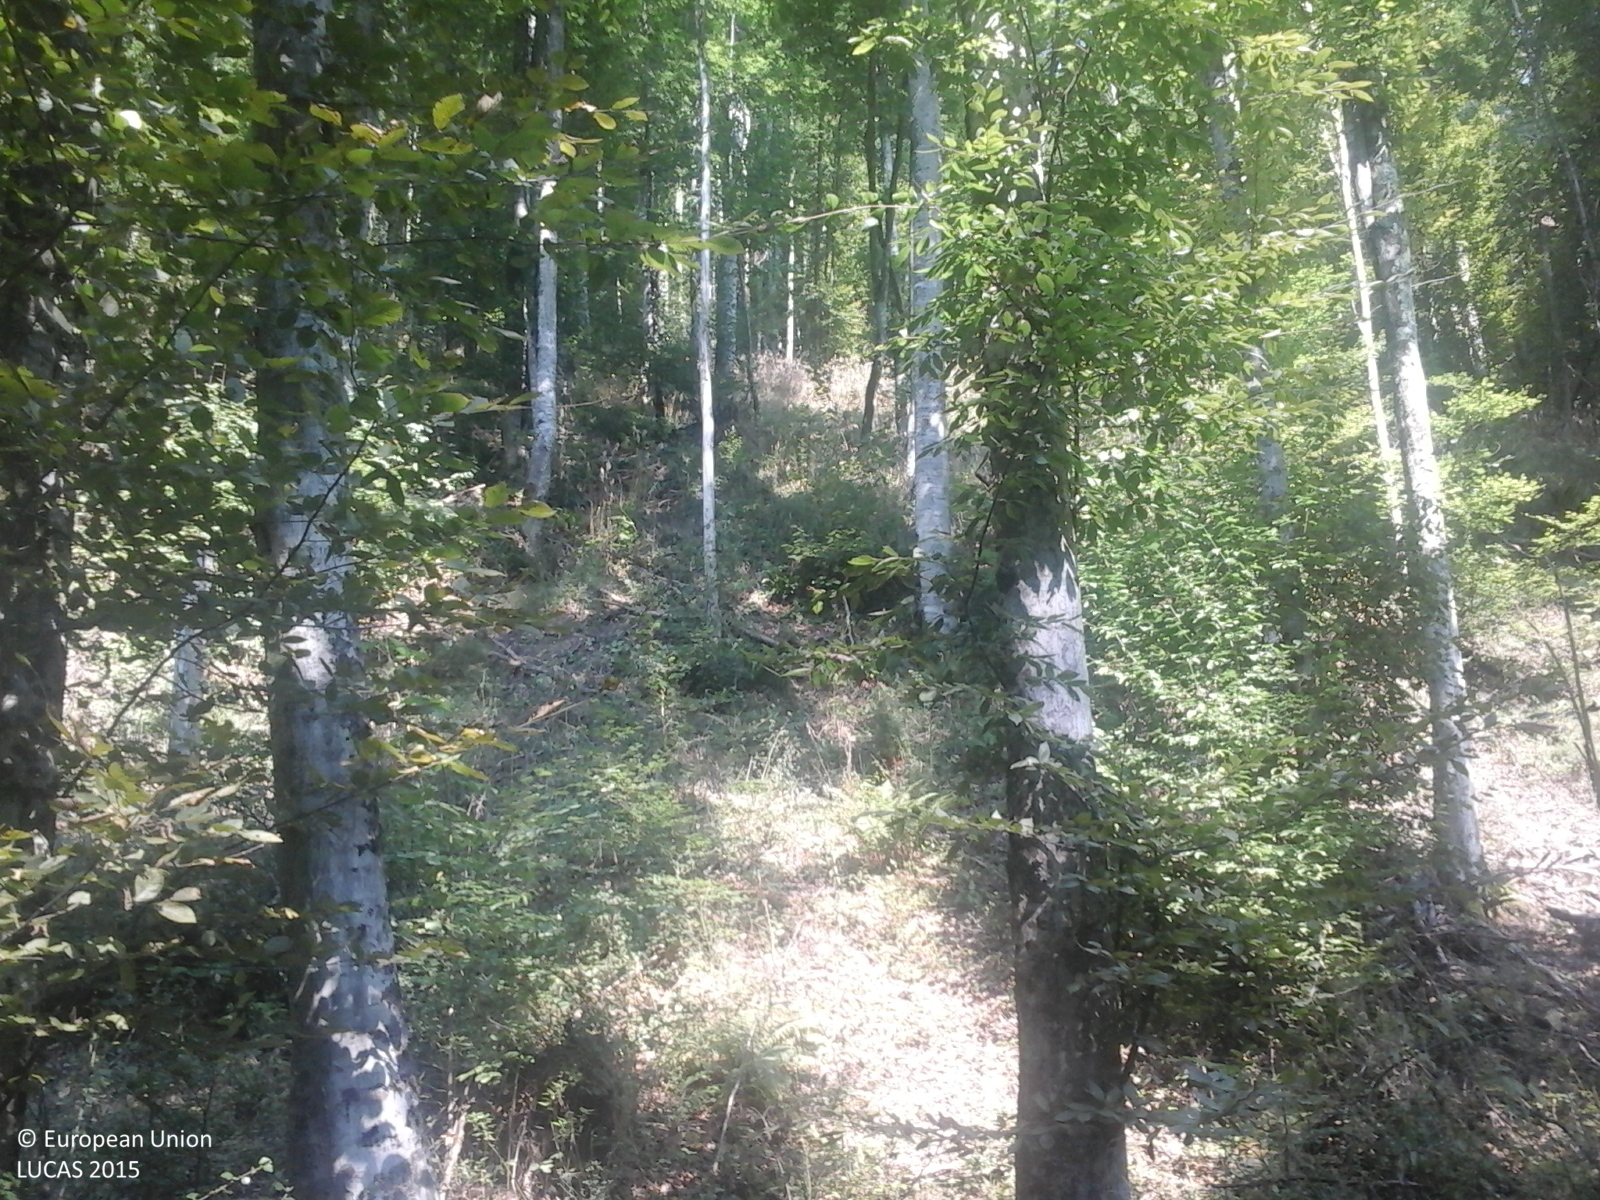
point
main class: Woodland
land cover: Broadleaved woodland
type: beech forest
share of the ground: > 75 %
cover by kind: broadleaved forest trees 100 %
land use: Forestry
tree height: > 5 m
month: August
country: RO
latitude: 46.5788
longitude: 22.1962
